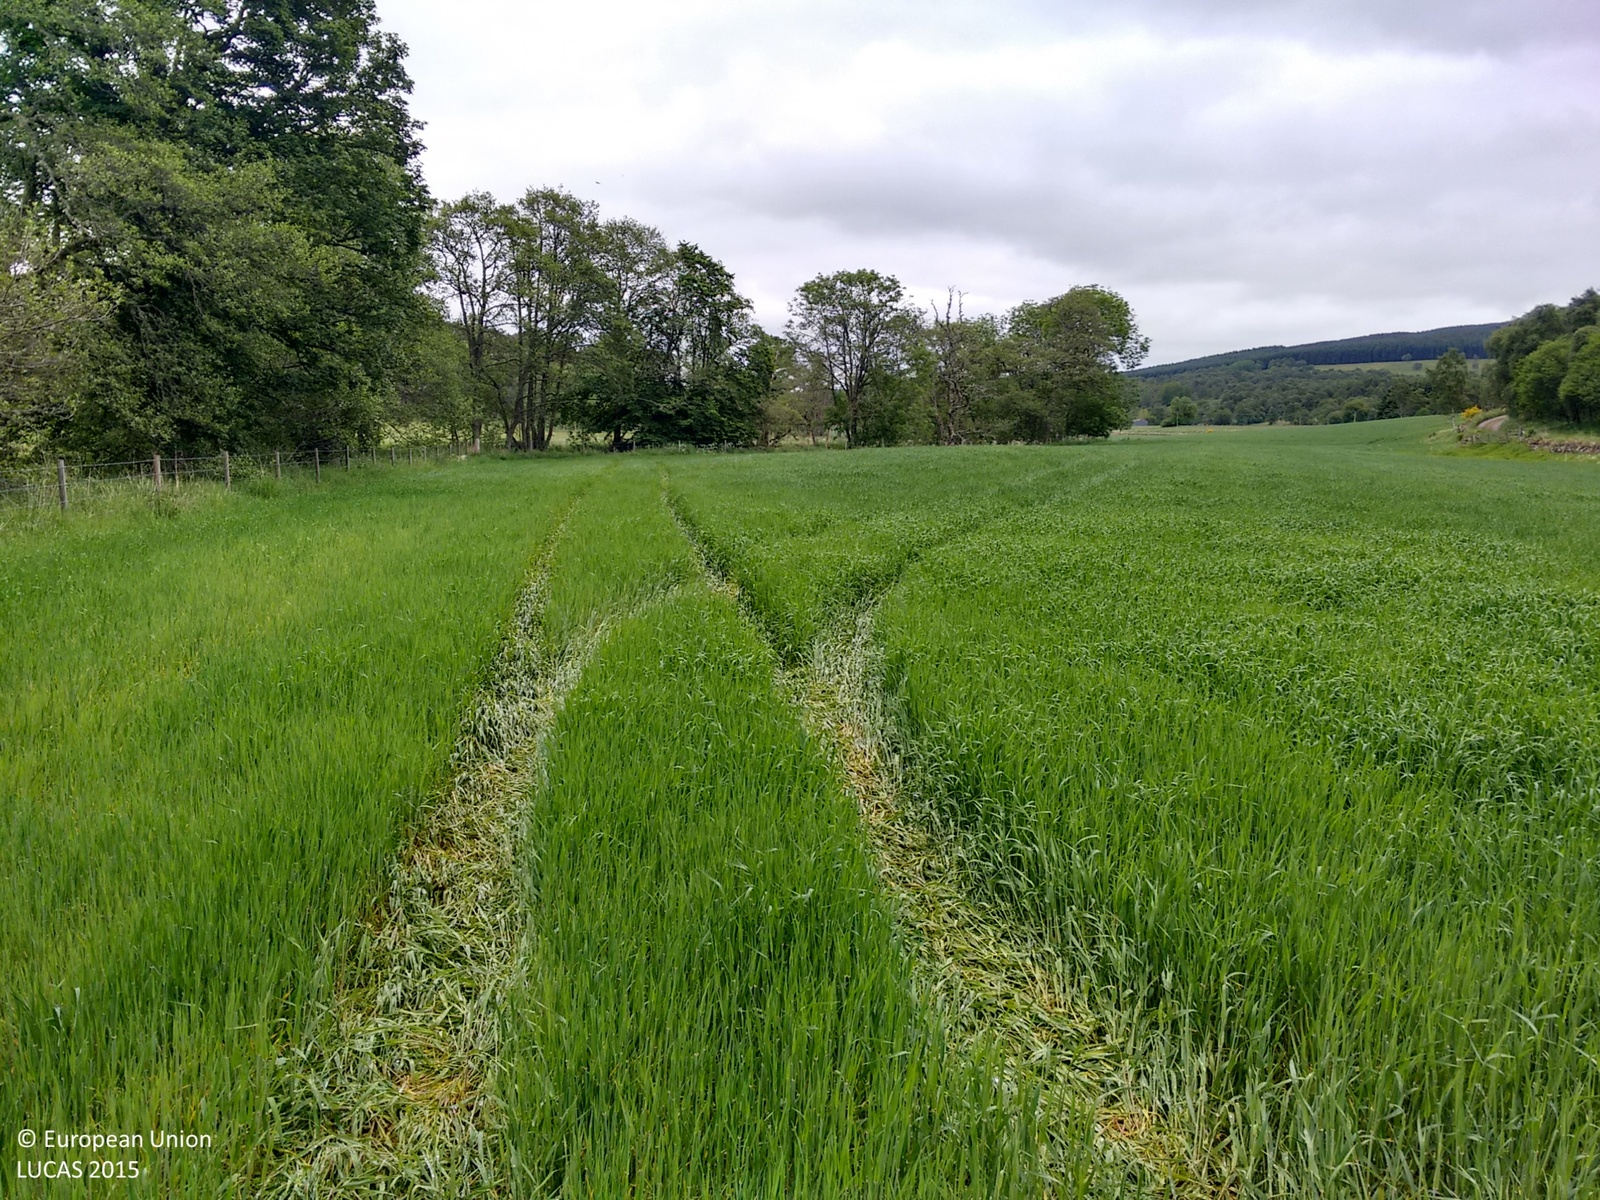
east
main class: Cropland
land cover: Barley
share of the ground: > 75 %
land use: Agriculture (excluding fallow land and kitchen gardens)
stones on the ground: < 10 %
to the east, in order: Barley; Grass margins; Fences; Grass margins; Rivers and streams; Broadleaved woodland; Fences; Grassland without tree/shrub cover; Fences; Broadleaved woodland; Fences; Rivers and streams; Spontaneously vegetated surfaces; Barley
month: June
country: GB
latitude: 57.0515
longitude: -2.6690
